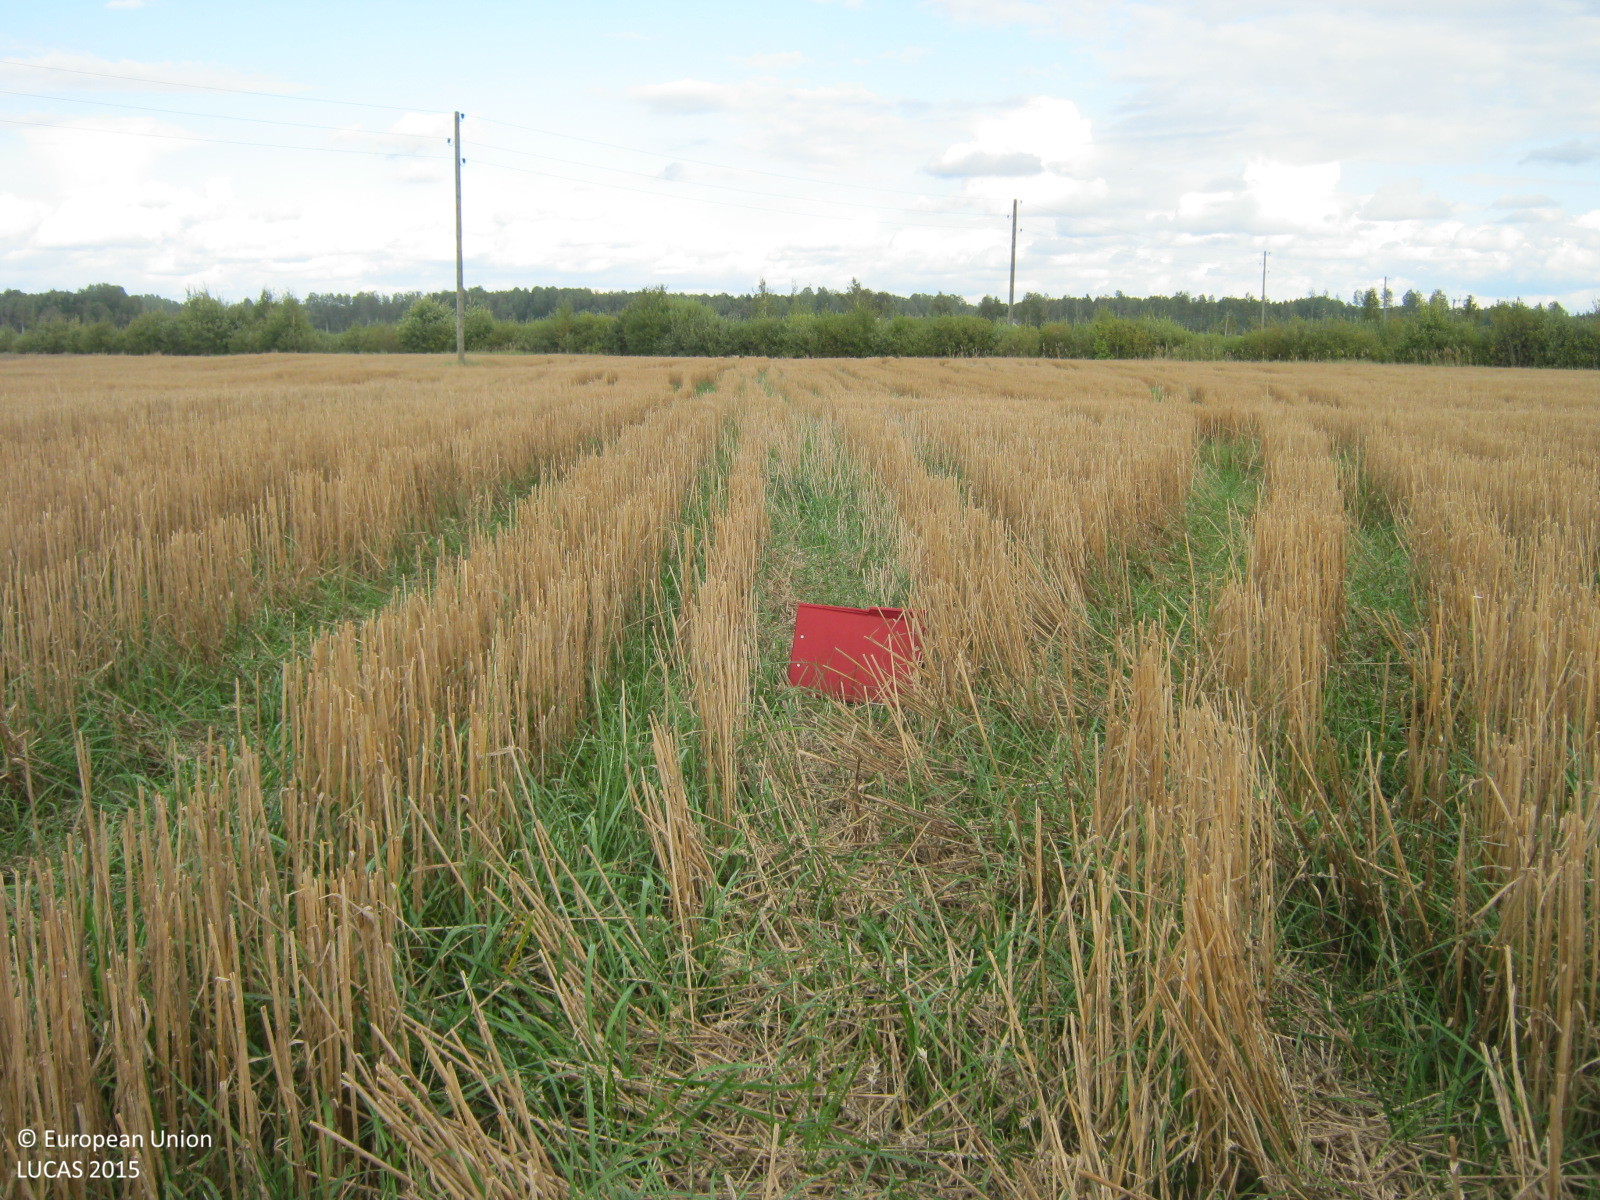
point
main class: Cropland
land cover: Common wheat
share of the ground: 50 - 75 %
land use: Agriculture (excluding fallow land and kitchen gardens)
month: September
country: LV
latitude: 57.3463
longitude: 24.5671
